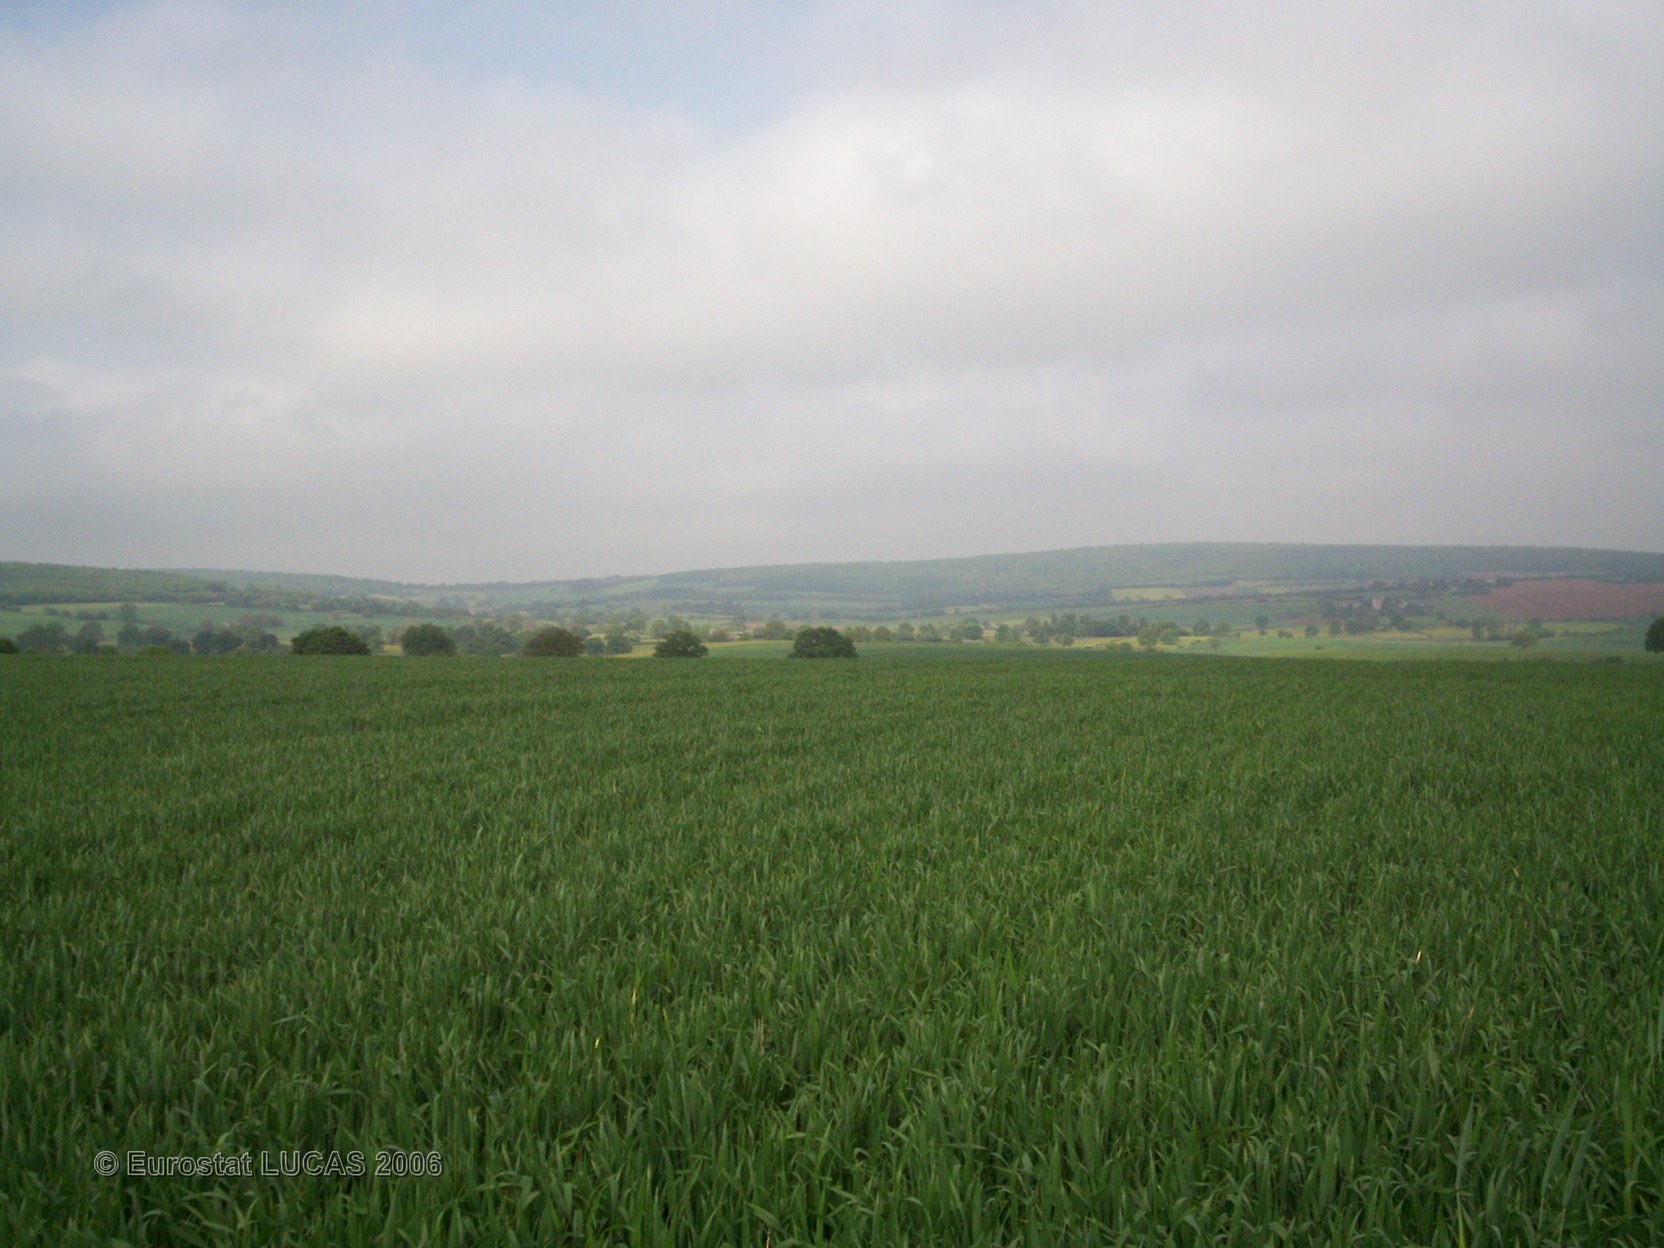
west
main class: Cropland
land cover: Common wheat
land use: Agriculture (excluding fallow land and kitchen gardens)
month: May
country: FR
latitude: 46.5072
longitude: 4.6715
